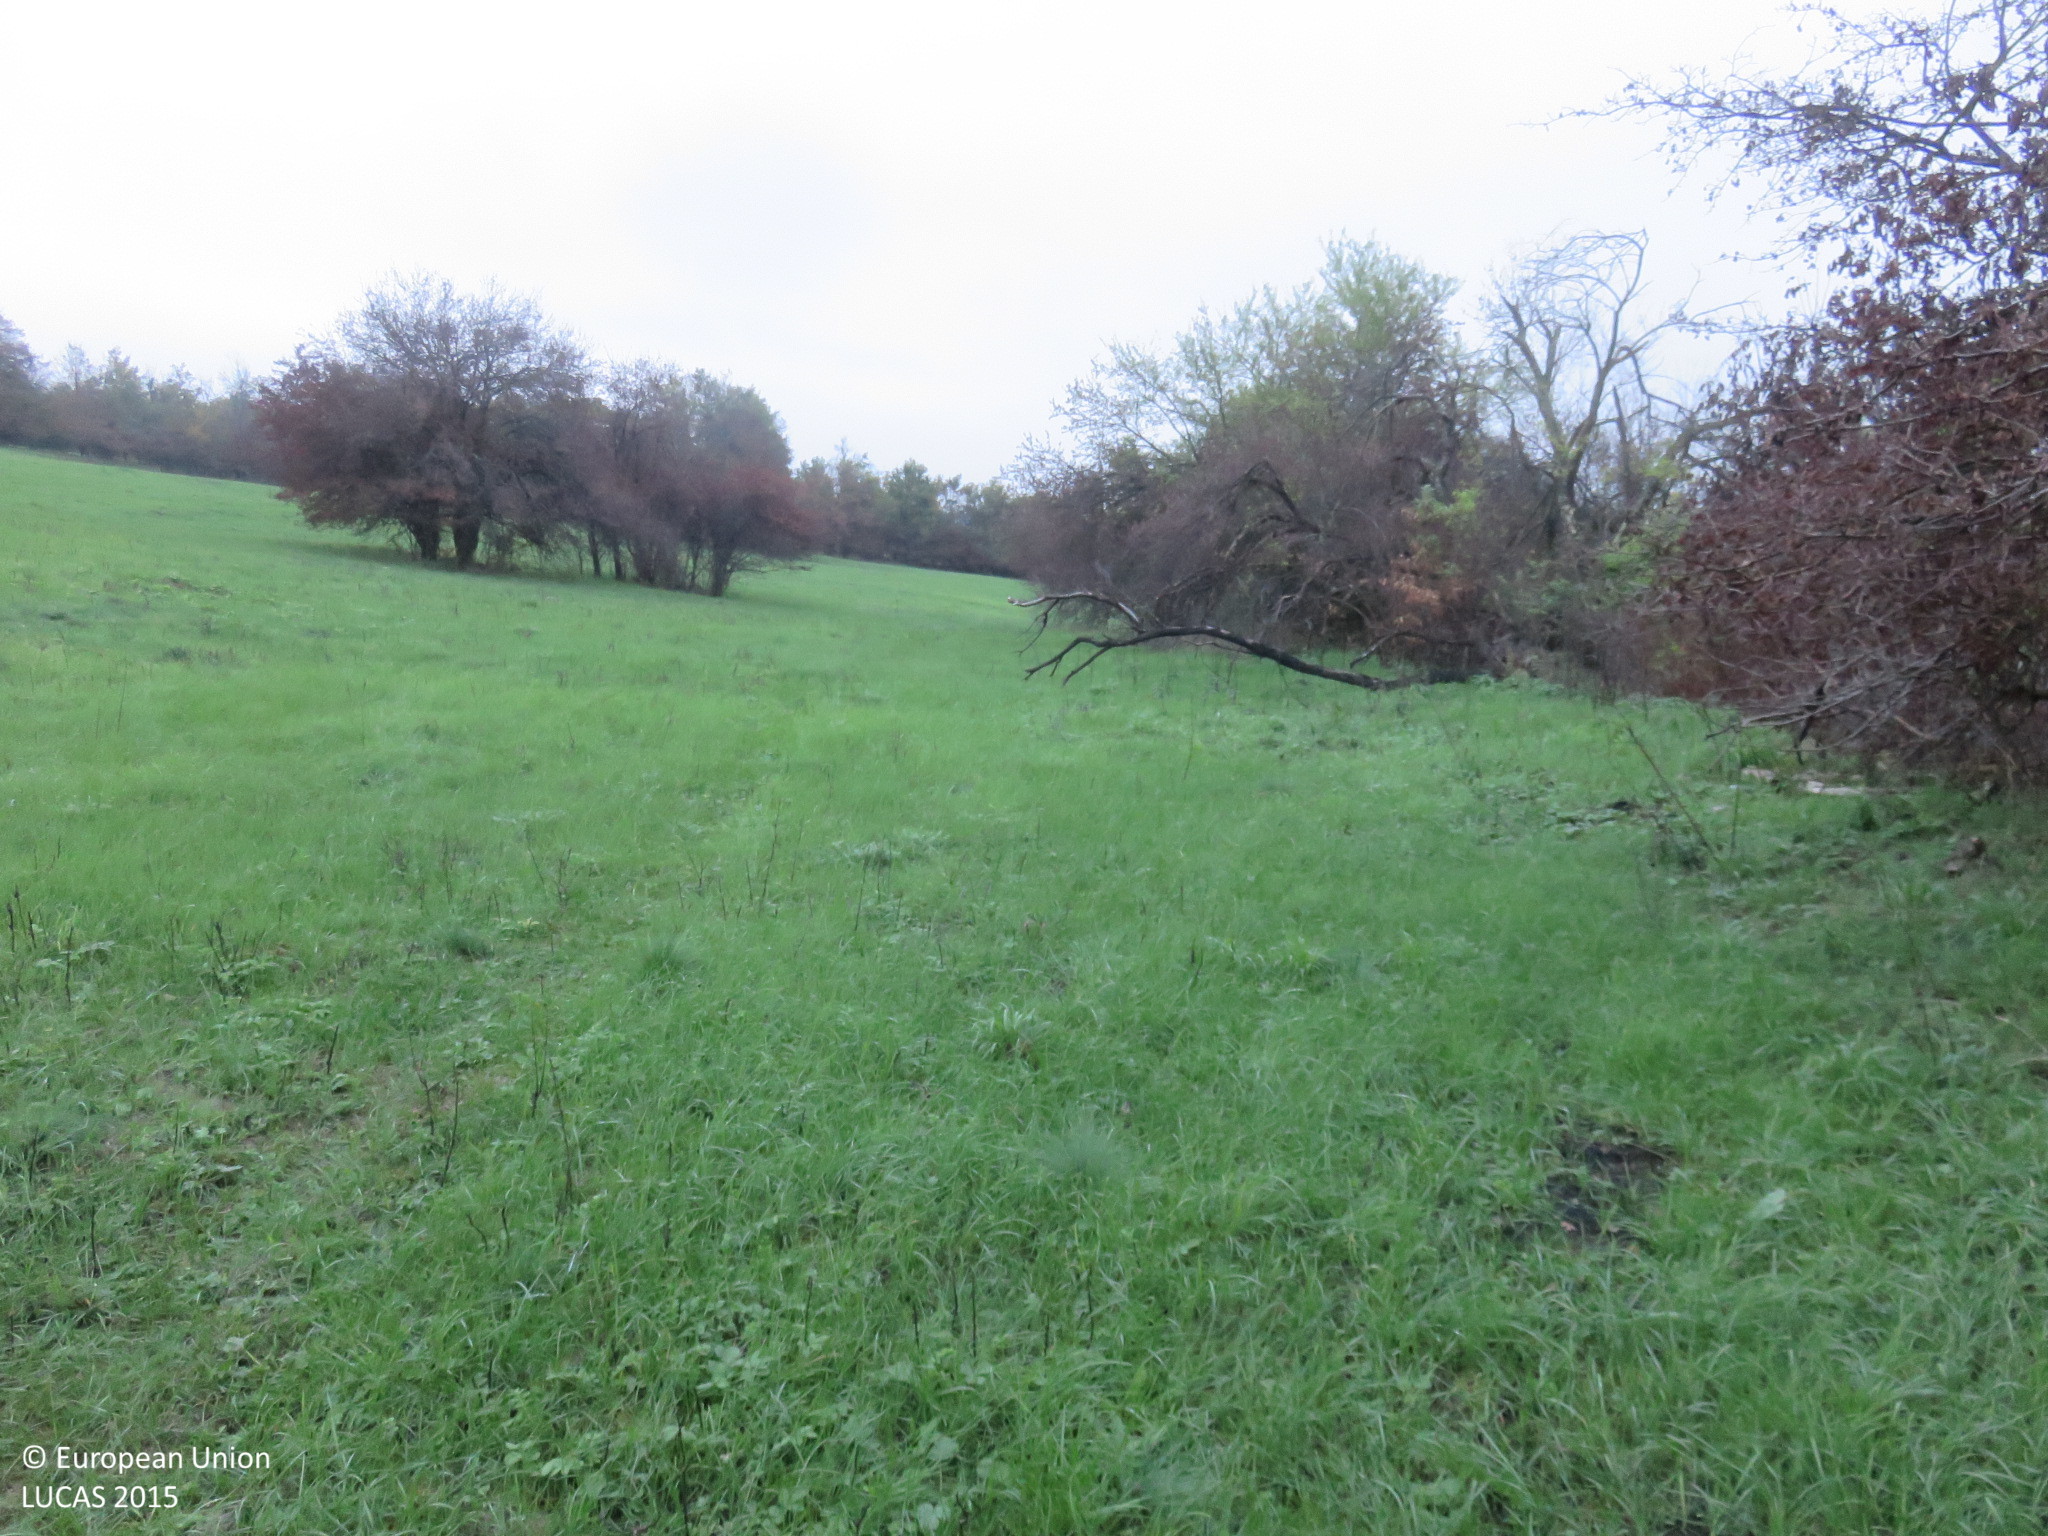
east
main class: Grassland
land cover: Grassland without tree/shrub cover
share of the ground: > 75 %
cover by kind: herbaceous plants 100 %
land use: Agriculture (excluding fallow land and kitchen gardens)
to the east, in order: Grassland without tree/shrub cover; Broadleaved woodland; Grassland without tree/shrub cover; Tracks; Grassland without tree/shrub cover; Abandoned hedges; Grassland without tree/shrub cover
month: October
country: BG
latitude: 42.9539
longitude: 25.2826
